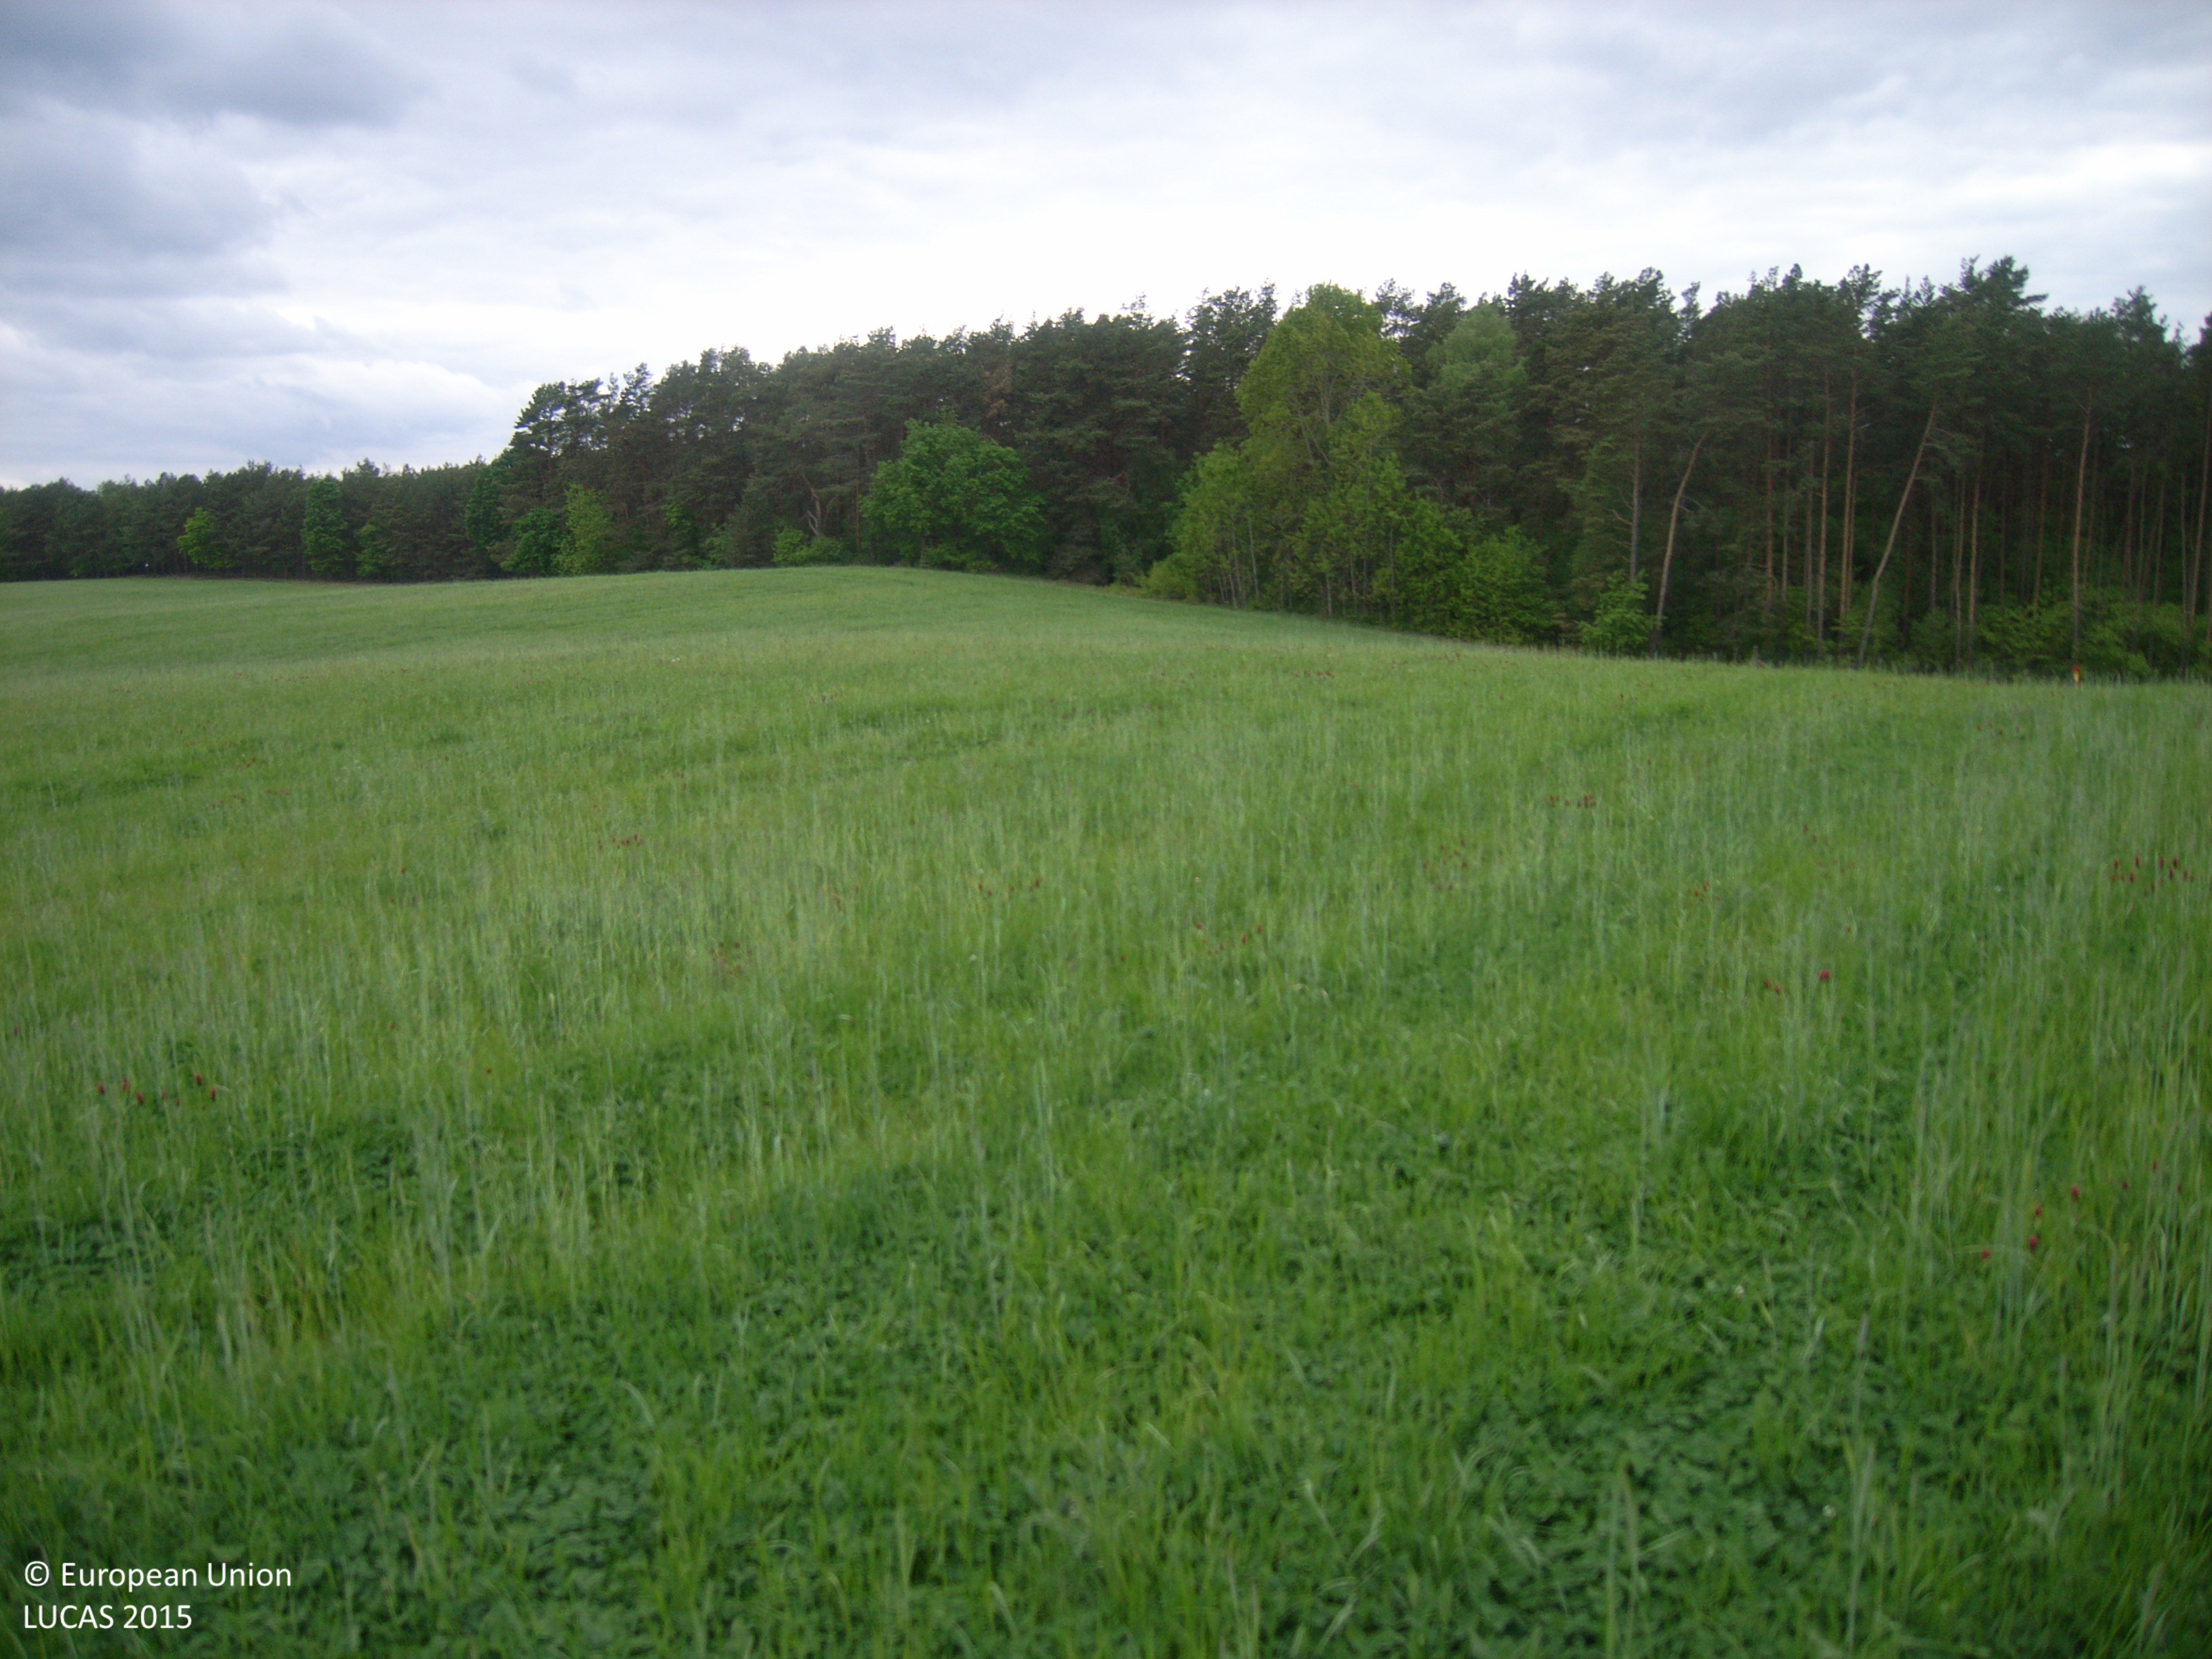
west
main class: Cropland
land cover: Other leguminous and mixtures for fodder
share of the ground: > 75 %
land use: Agriculture (excluding fallow land and kitchen gardens)
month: May
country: DE
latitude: 52.1436
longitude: 13.5805
